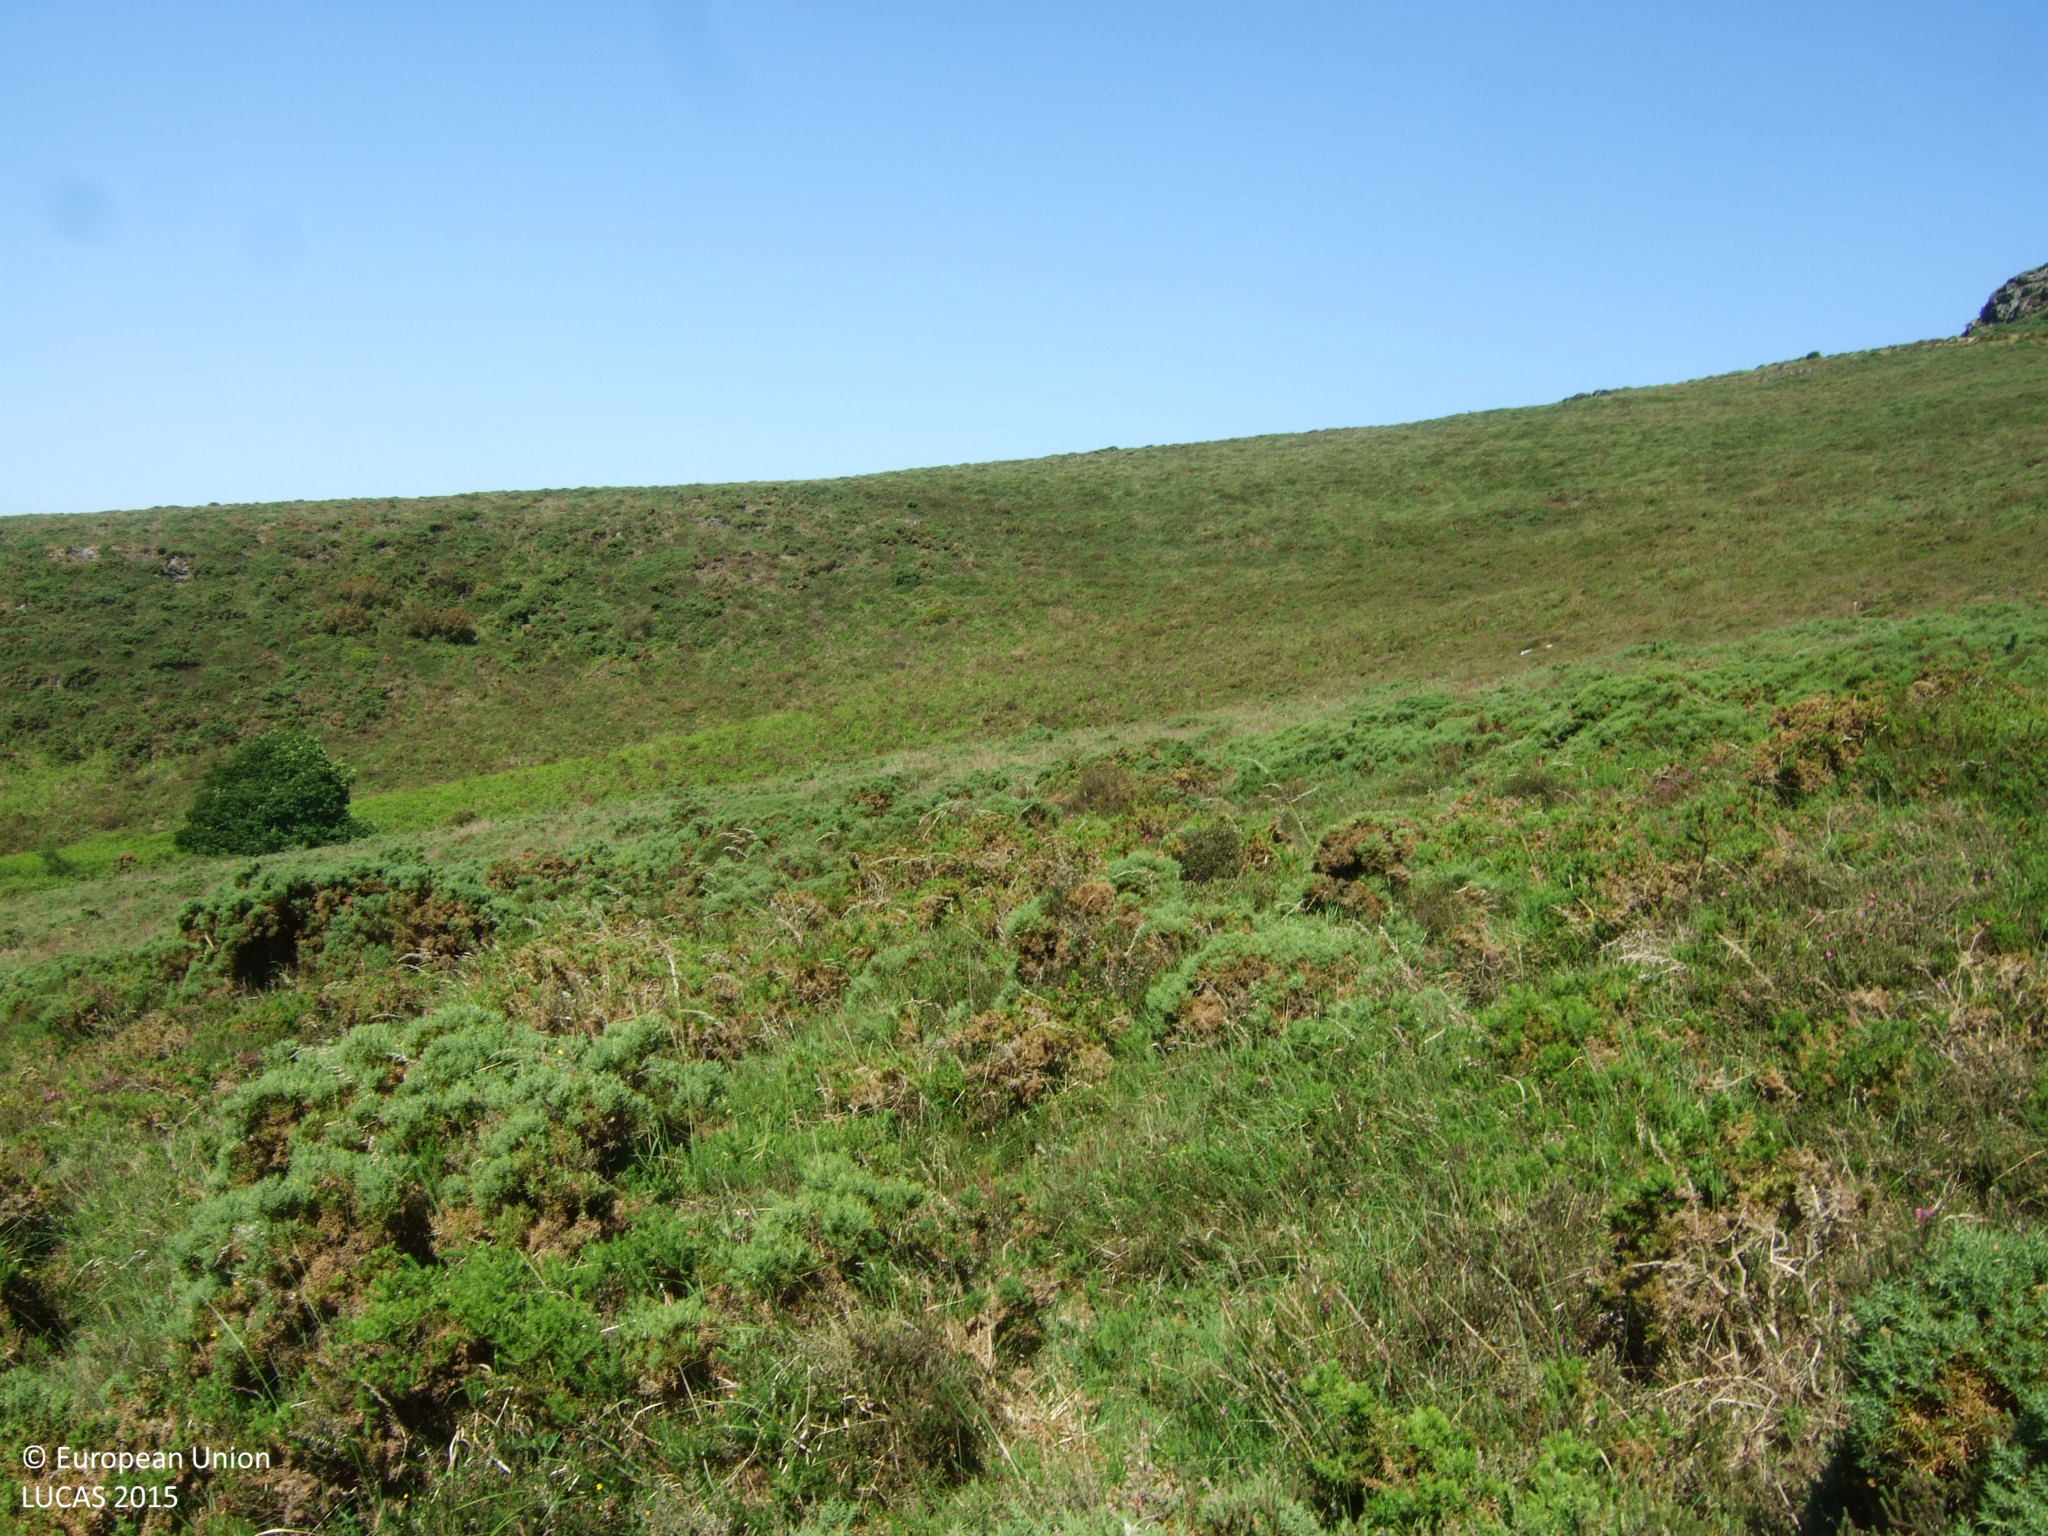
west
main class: Shrubland
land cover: Shrubland without tree cover
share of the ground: > 75 %
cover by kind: shrubs 90 %, herbaceous plants 10 %
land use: Semi-natural and natural areas not in use
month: June
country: ES
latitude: 43.4901
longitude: -7.7337
